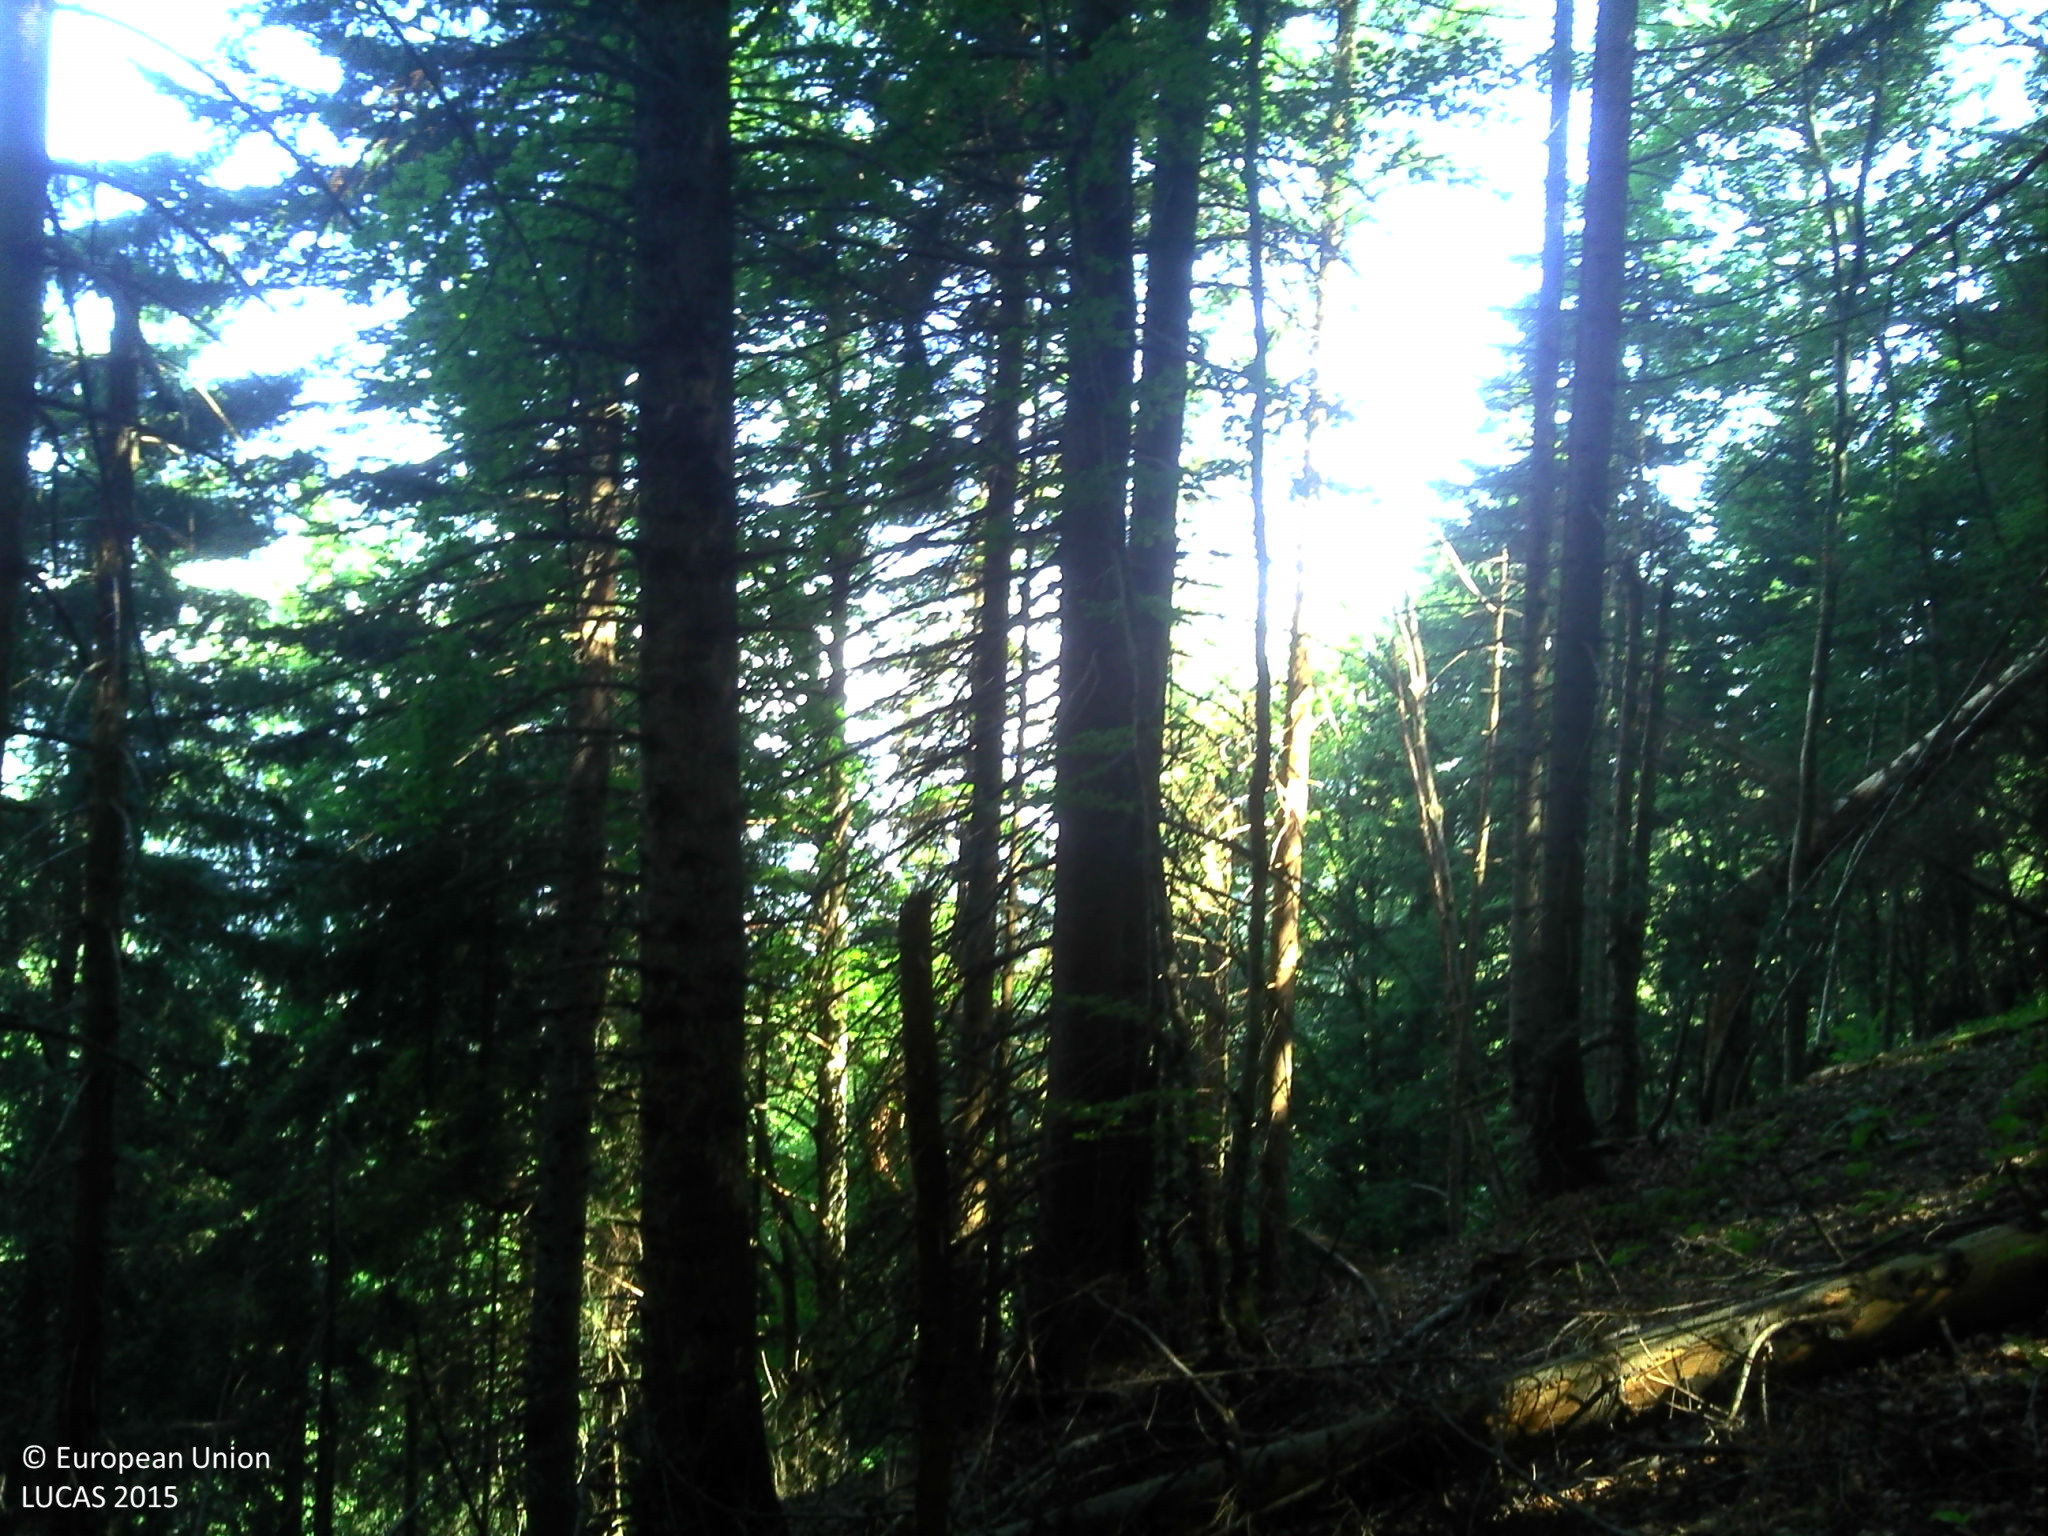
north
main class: Woodland
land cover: Spruce dominated mixed woodland
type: mountainous beech forest
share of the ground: > 75 %
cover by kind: coniferous forest trees 50 %, broadleaved forest trees 30 %, herbaceous plants 15 %, lichens and mosses 5 %
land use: Forestry
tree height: > 5 m
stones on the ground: 10 - 25 %
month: July
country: FR
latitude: 45.7593
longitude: 6.1600
